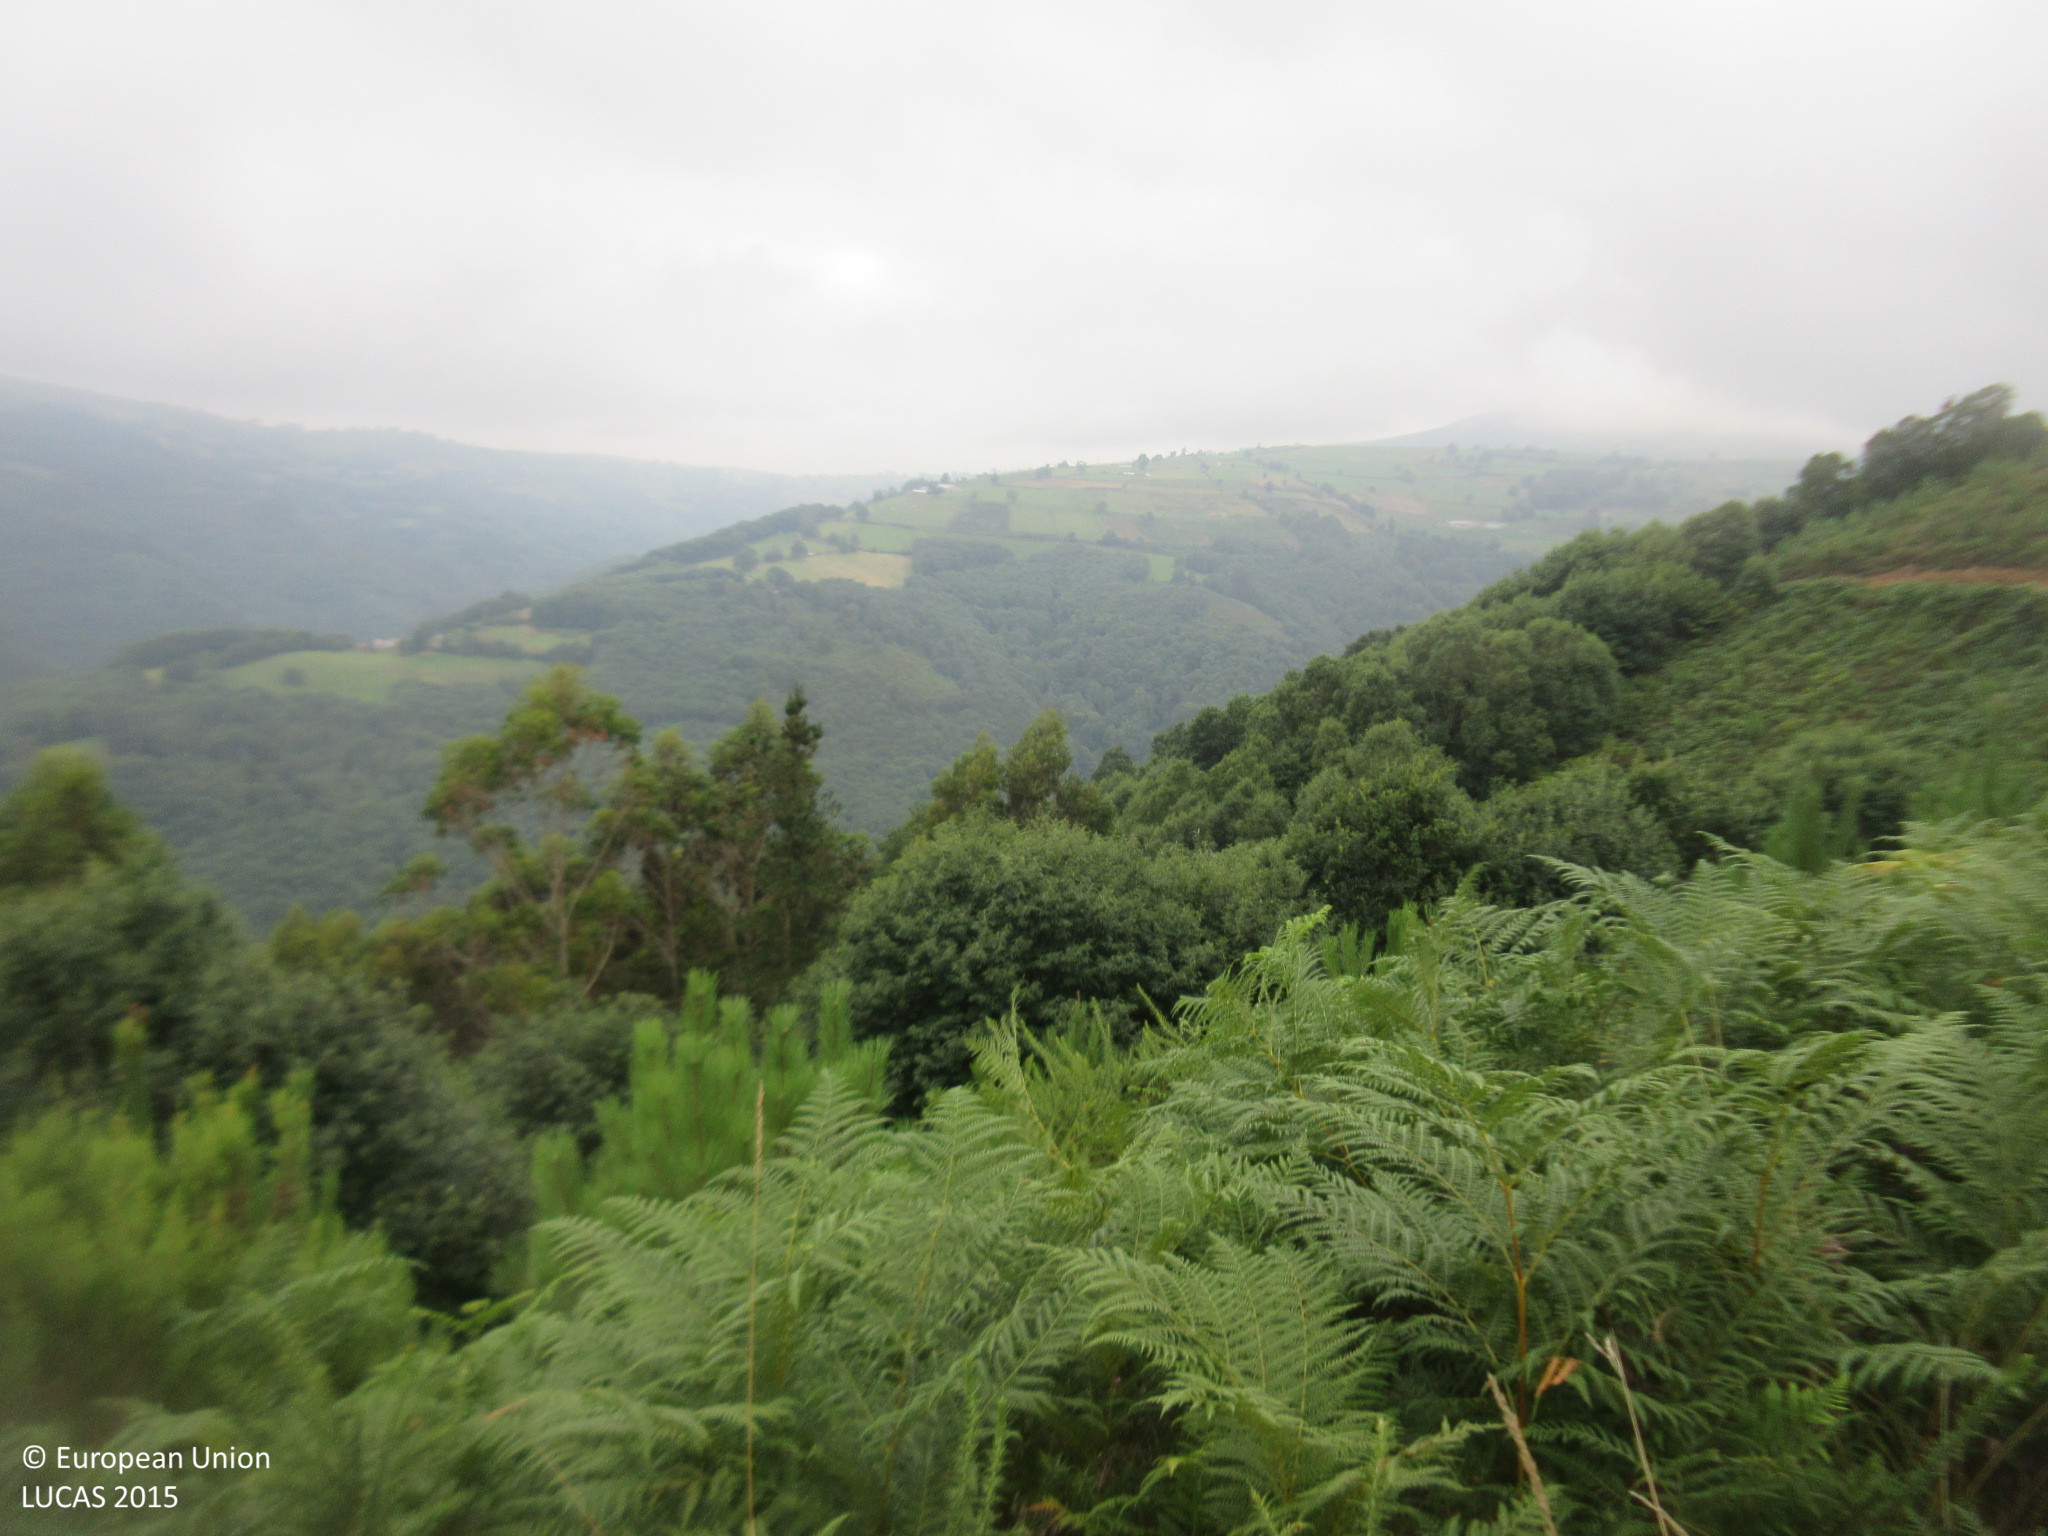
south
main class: Woodland
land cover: Pine dominated coniferous woodland
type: hemiboreal forest and nemoral coniferous forest and mixed broadleaved-coniferous forest
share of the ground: 50 - 75 %
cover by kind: coniferous forest trees 50 %, shrubs 50 %
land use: Forestry
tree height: > 5 m
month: August
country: ES
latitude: 43.4260
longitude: -6.3687
